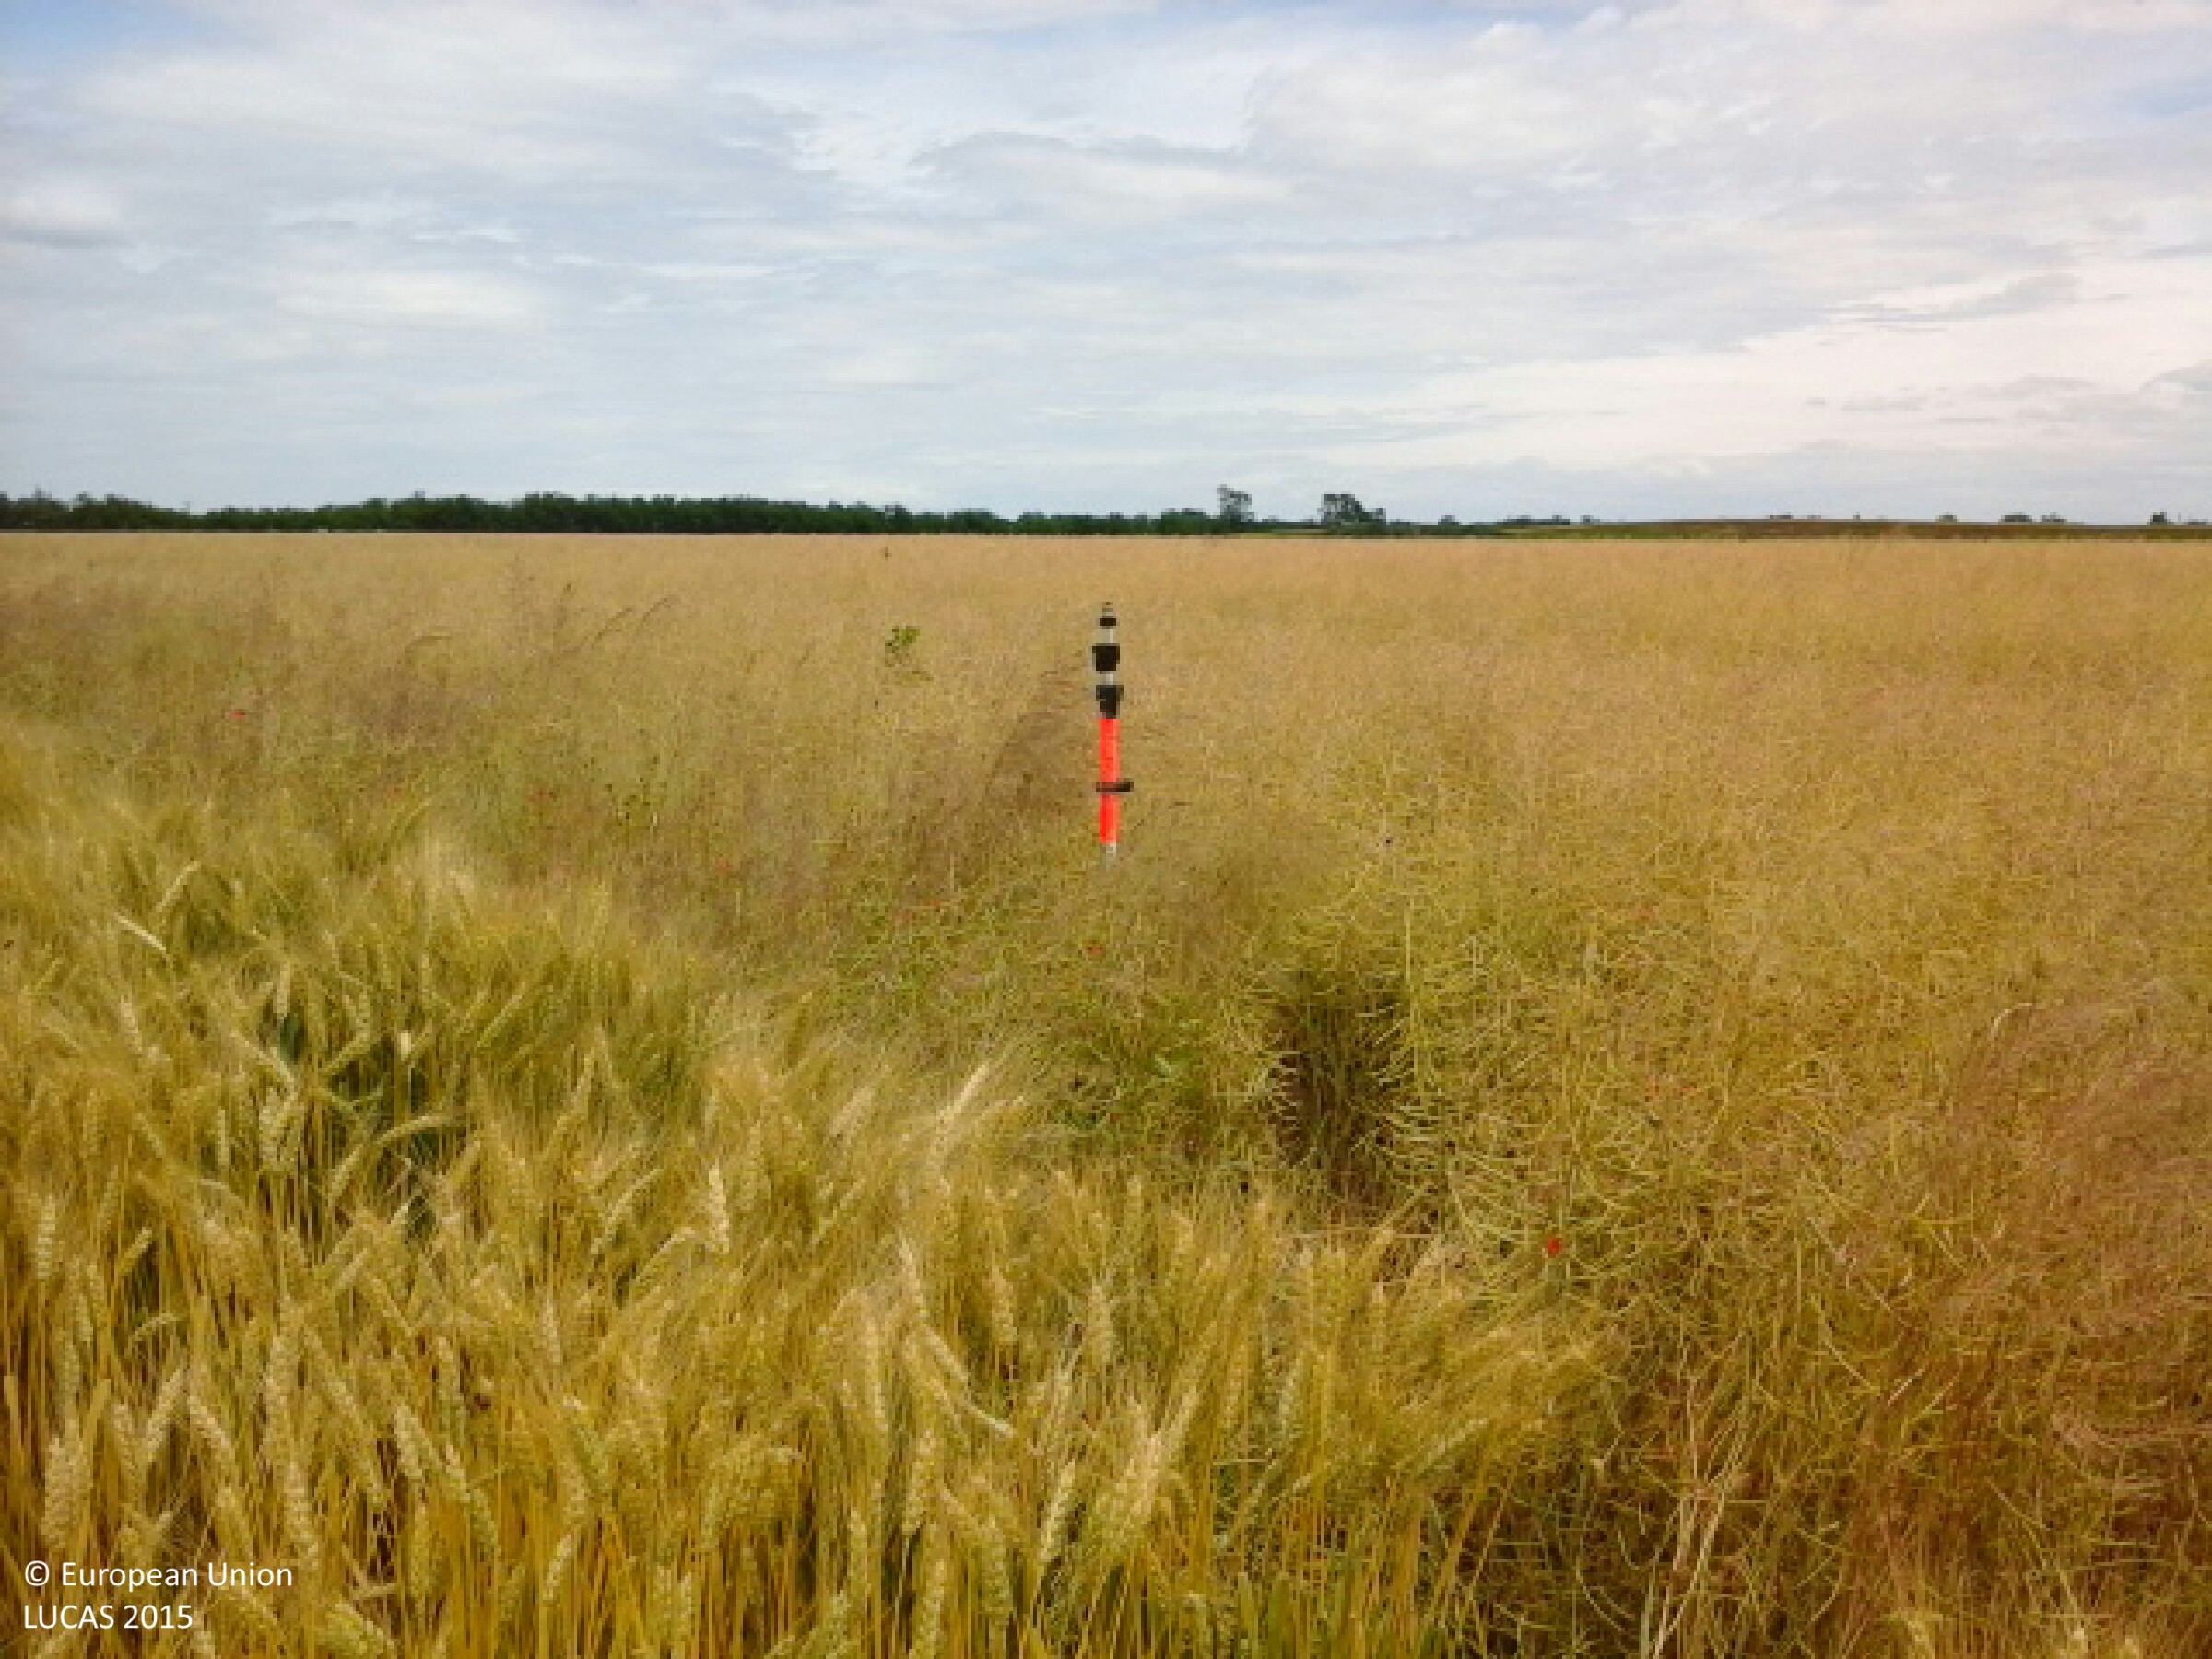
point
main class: Cropland
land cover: Rape and turnip rape
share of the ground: > 75 %
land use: Agriculture (excluding fallow land and kitchen gardens)
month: June
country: HU
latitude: 47.9801
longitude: 21.5270
